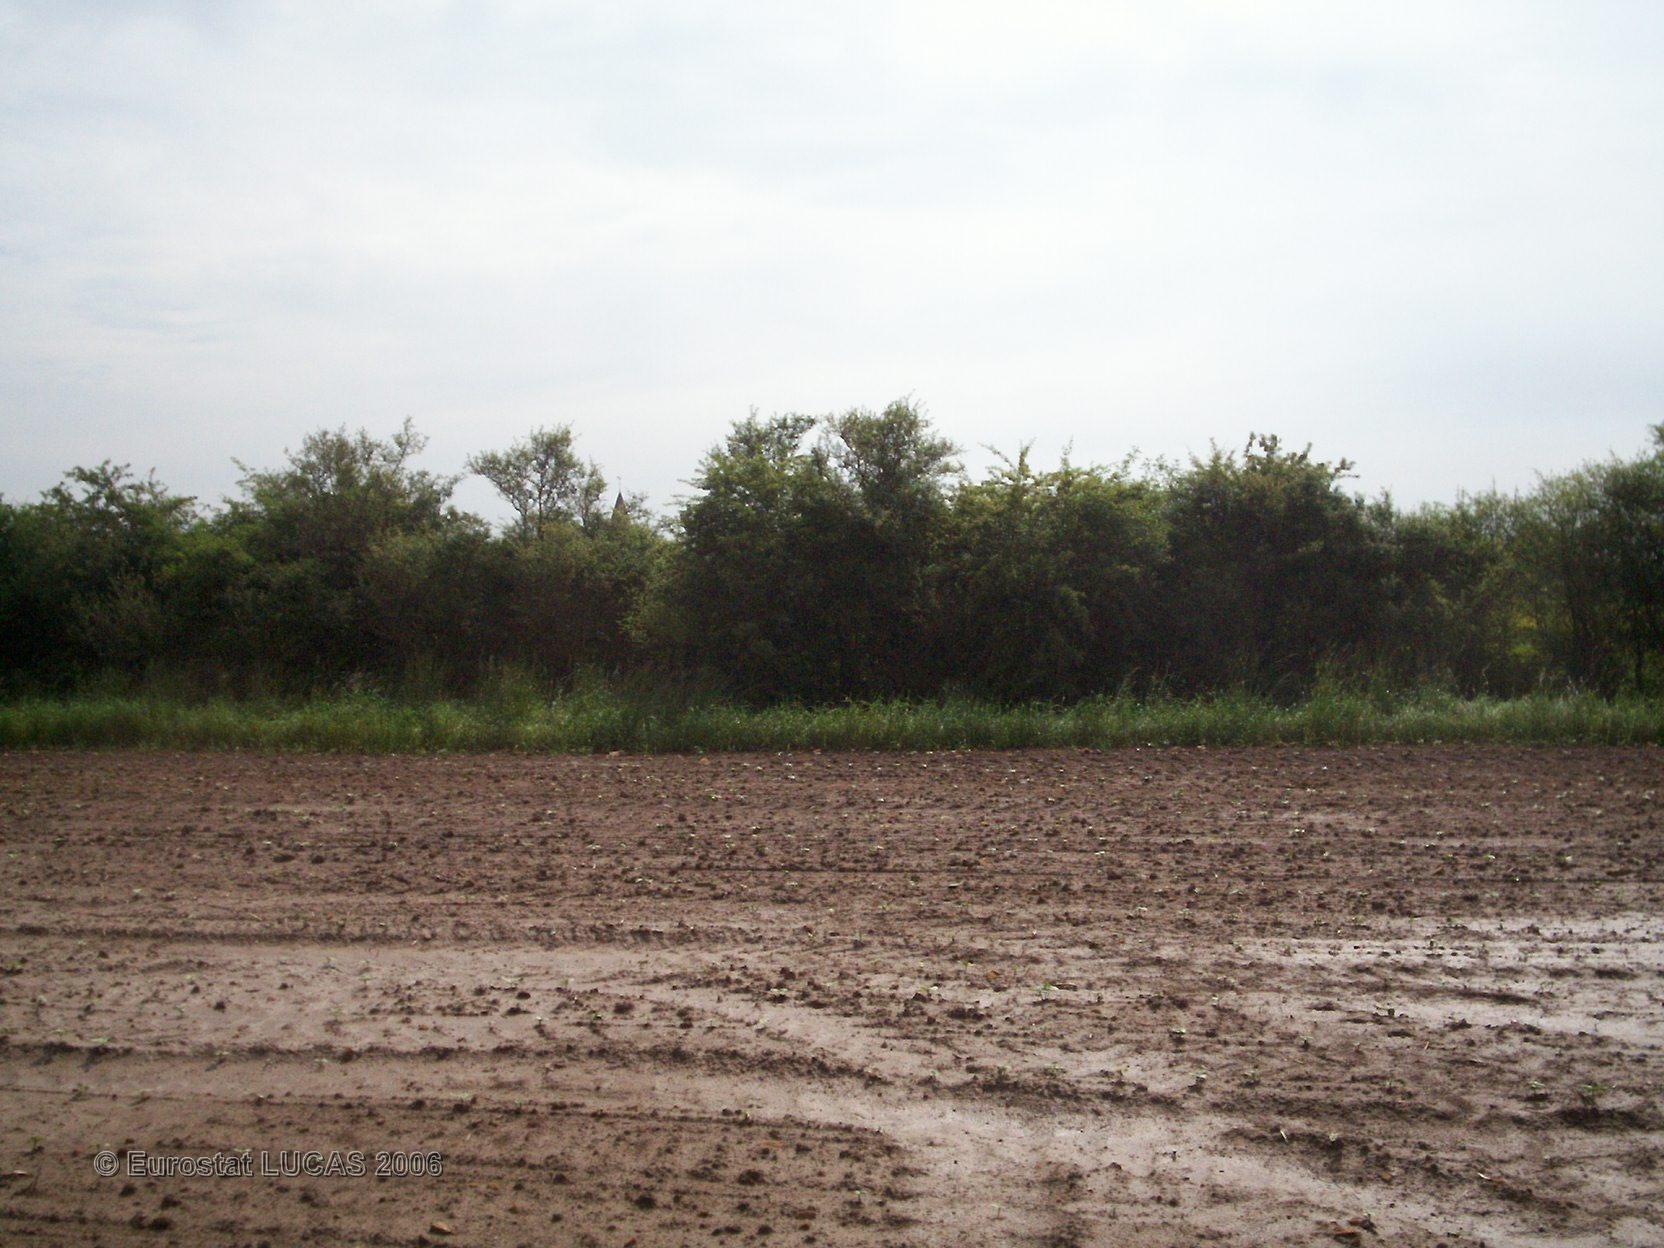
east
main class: Cropland
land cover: Sunflower
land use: Agriculture (excluding fallow land and kitchen gardens)
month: May
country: FR
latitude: 46.7445
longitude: 4.7263
